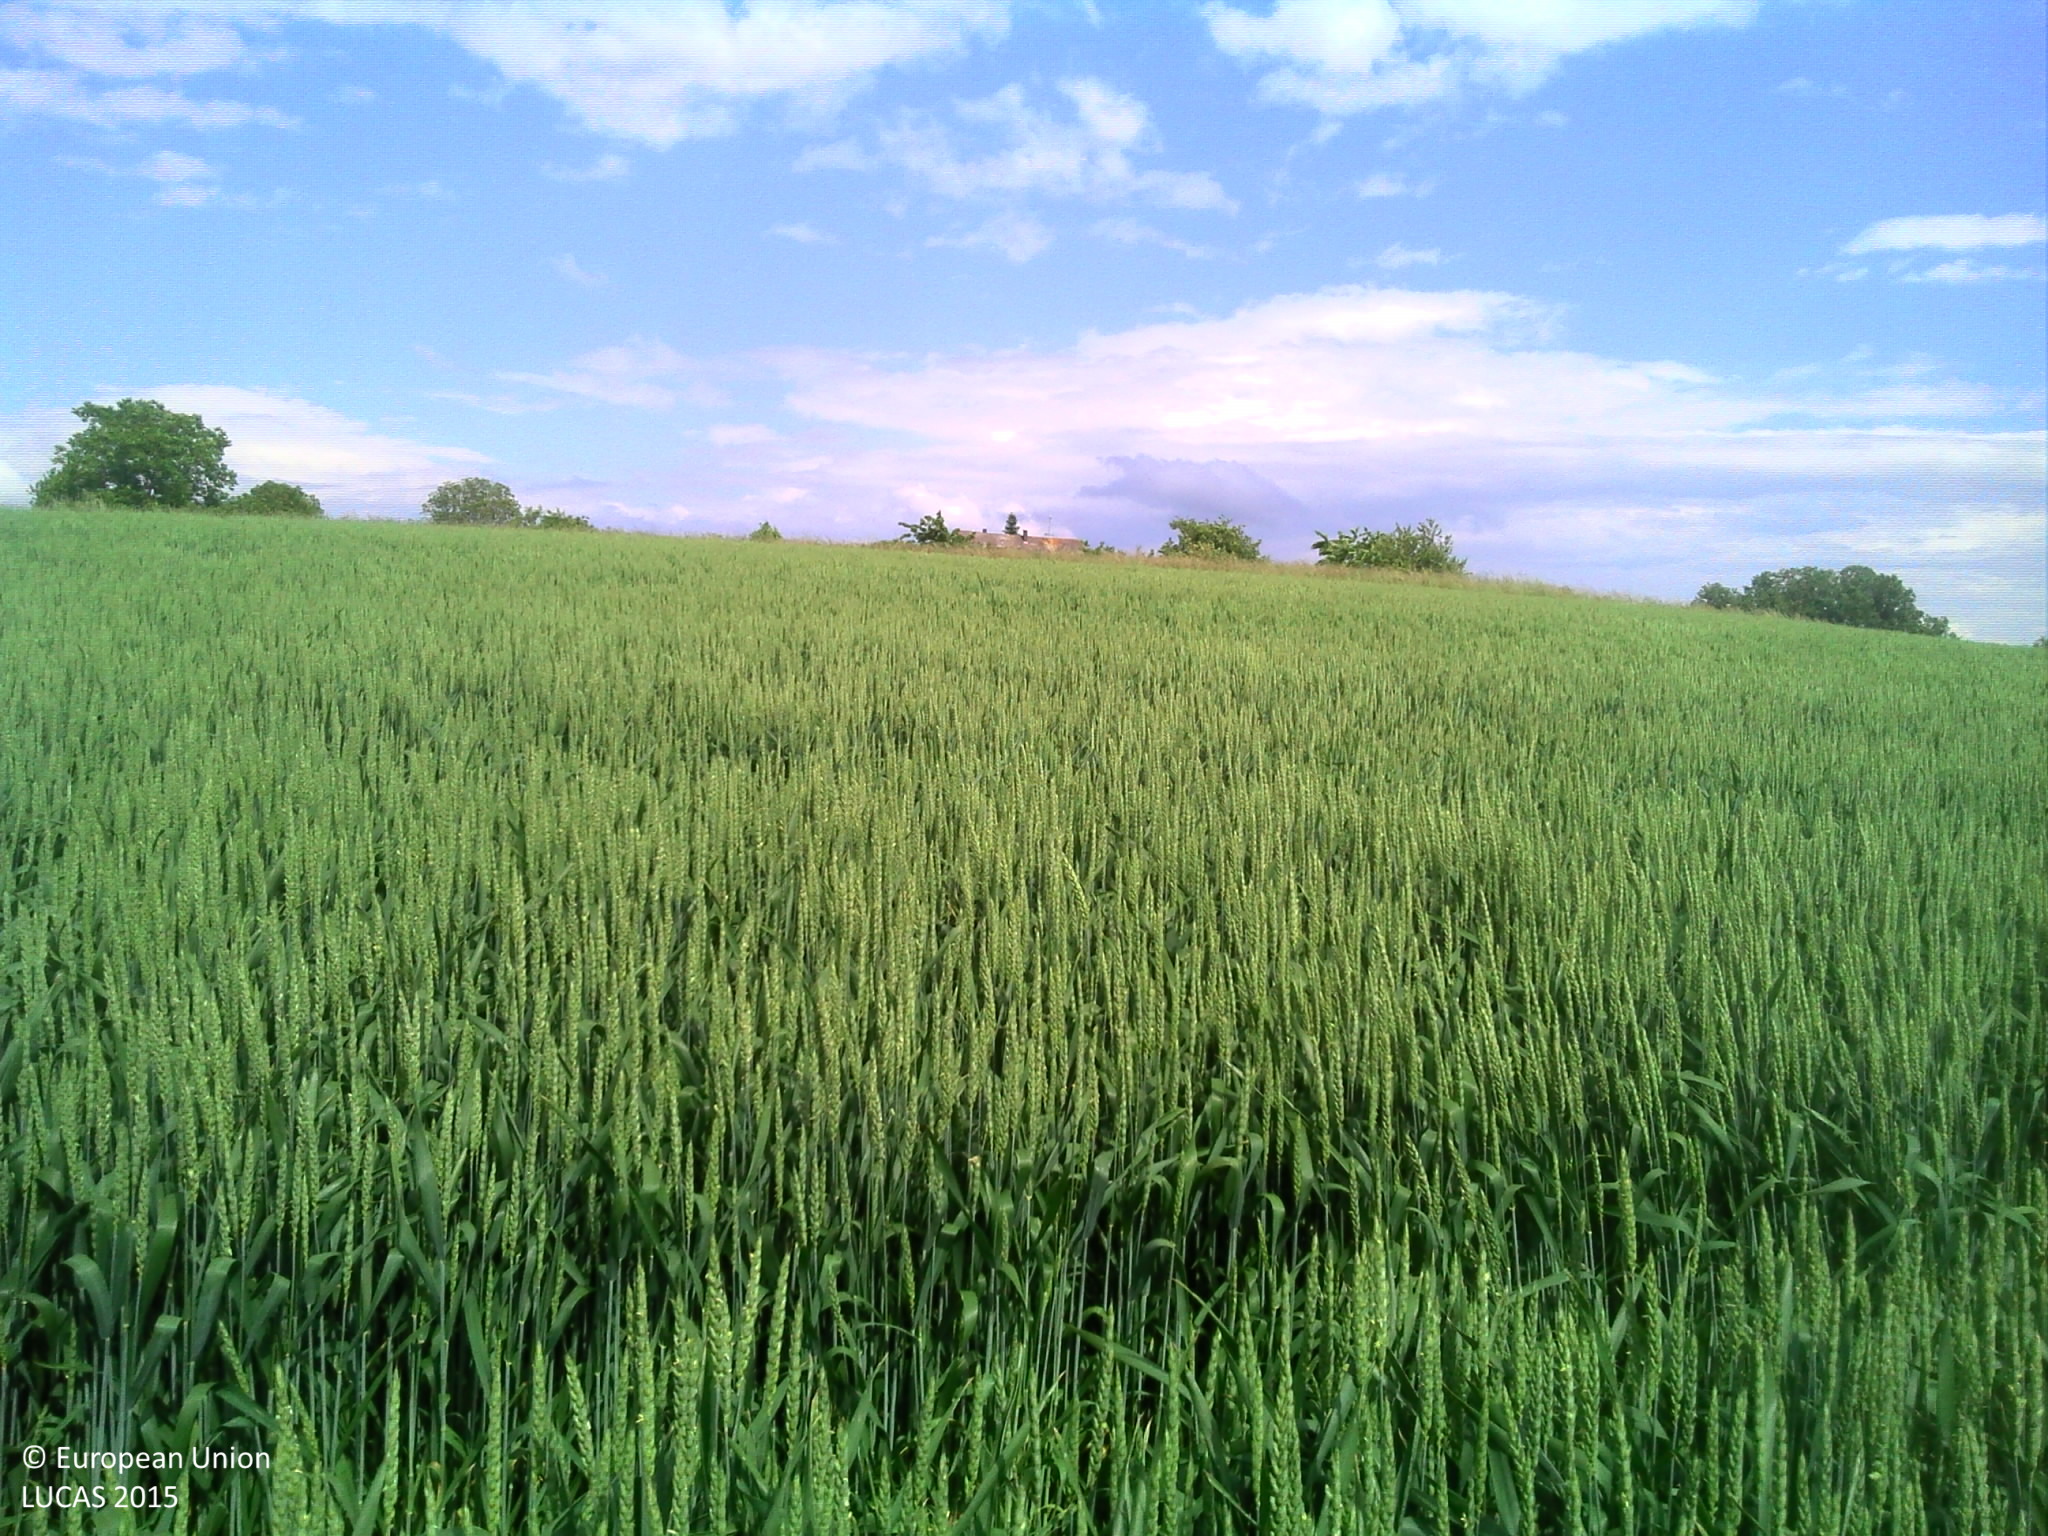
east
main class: Cropland
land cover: Common wheat
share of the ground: > 75 %
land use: Agriculture (excluding fallow land and kitchen gardens)
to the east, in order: Common wheat; Grassland without tree/shrub cover; Grassland with sparse tree/shrub cover; Grassland without tree/shrub cover; Lines of trees; Grassland without tree/shrub cover; Artificial constructions in urban areas; Grassland with sparse tree/shrub cover; Artificial constructions in urban areas
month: May
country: FR
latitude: 48.7151
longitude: 7.4048
